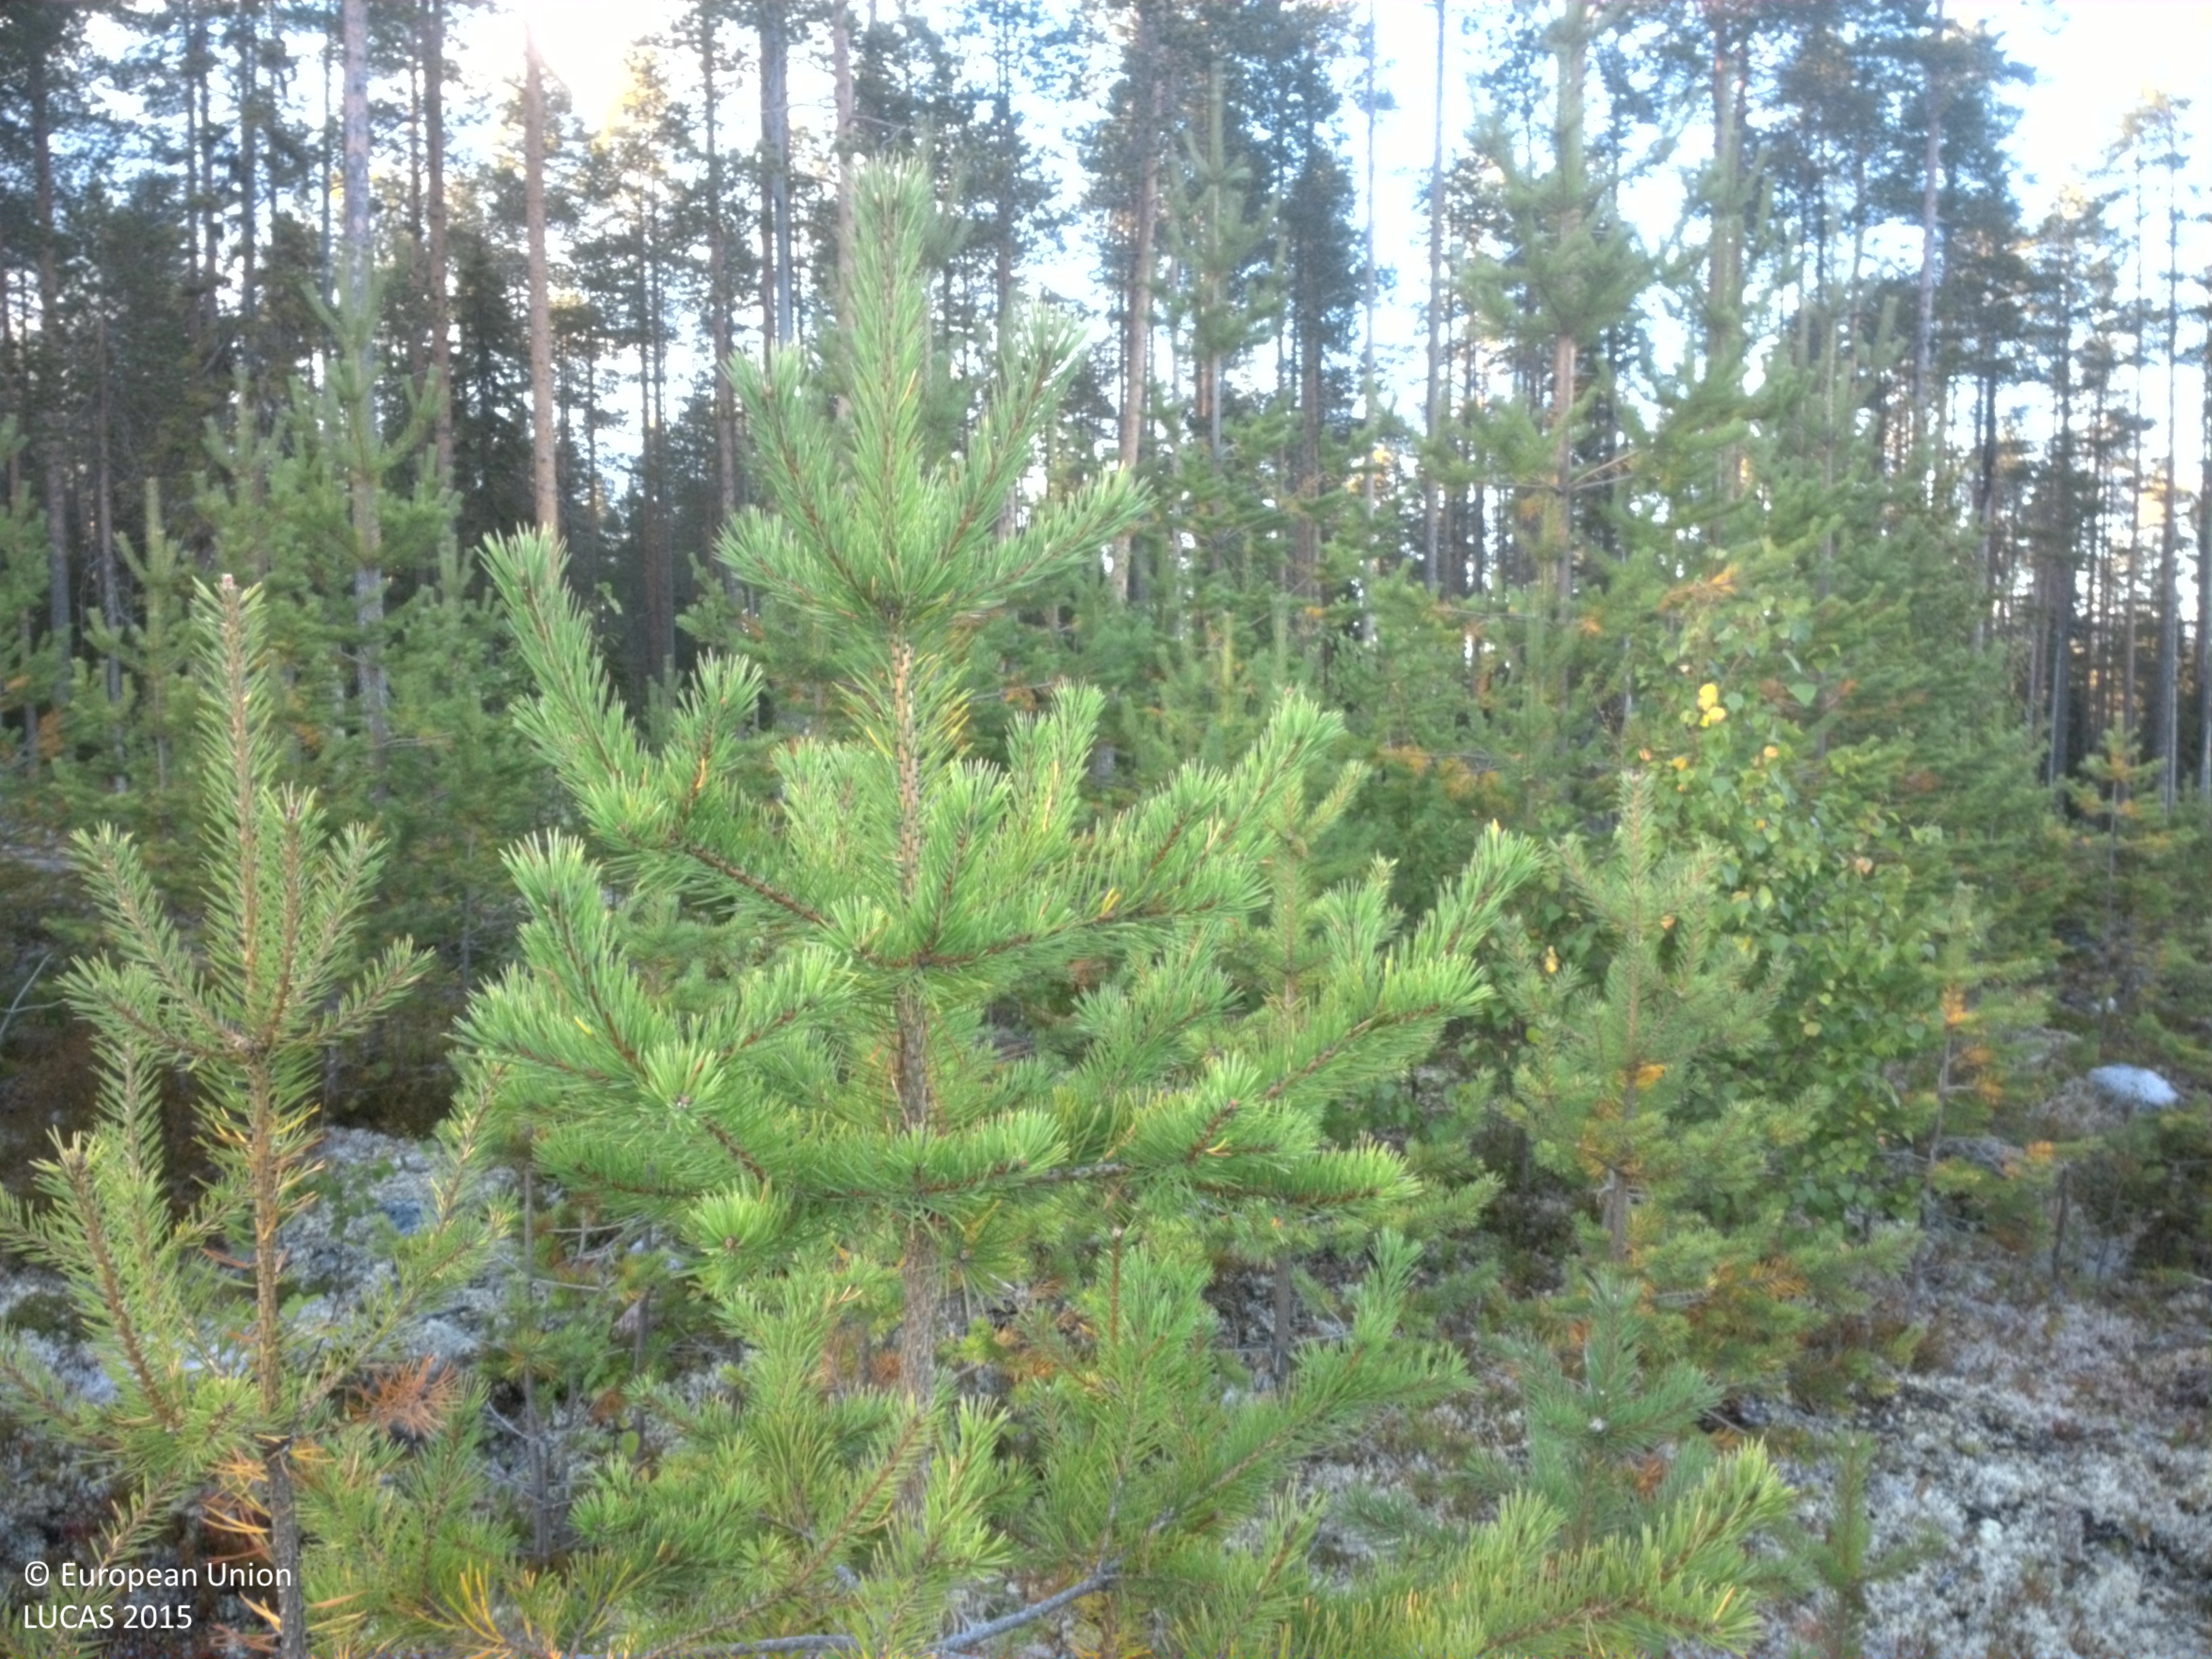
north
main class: Woodland
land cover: Pine dominated coniferous woodland
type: boreal forest
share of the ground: 25 - 50 %
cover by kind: coniferous forest trees 40 %, shrubs 30 %, lichens and mosses 30 %
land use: Forestry
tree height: > 5 m
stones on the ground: > 50 %
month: September
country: SE
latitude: 64.3923
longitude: 19.6991
